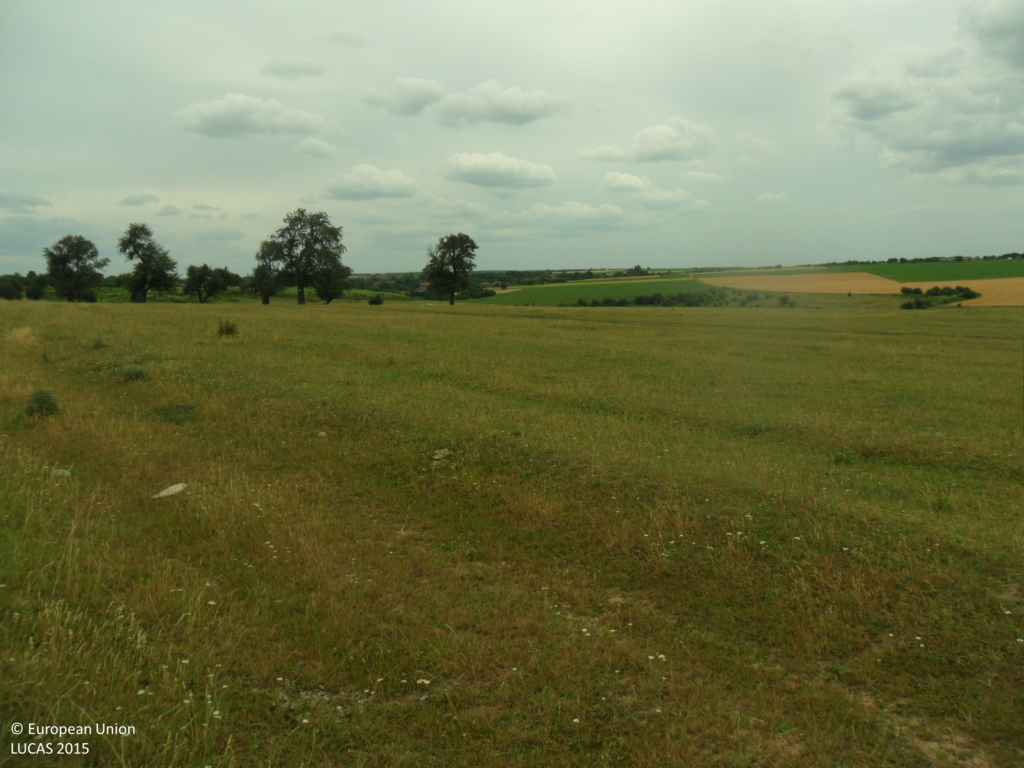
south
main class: Cropland
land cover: Common wheat
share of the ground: > 75 %
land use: Agriculture (excluding fallow land and kitchen gardens)
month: June
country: BG
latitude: 43.6552
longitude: 26.7654
